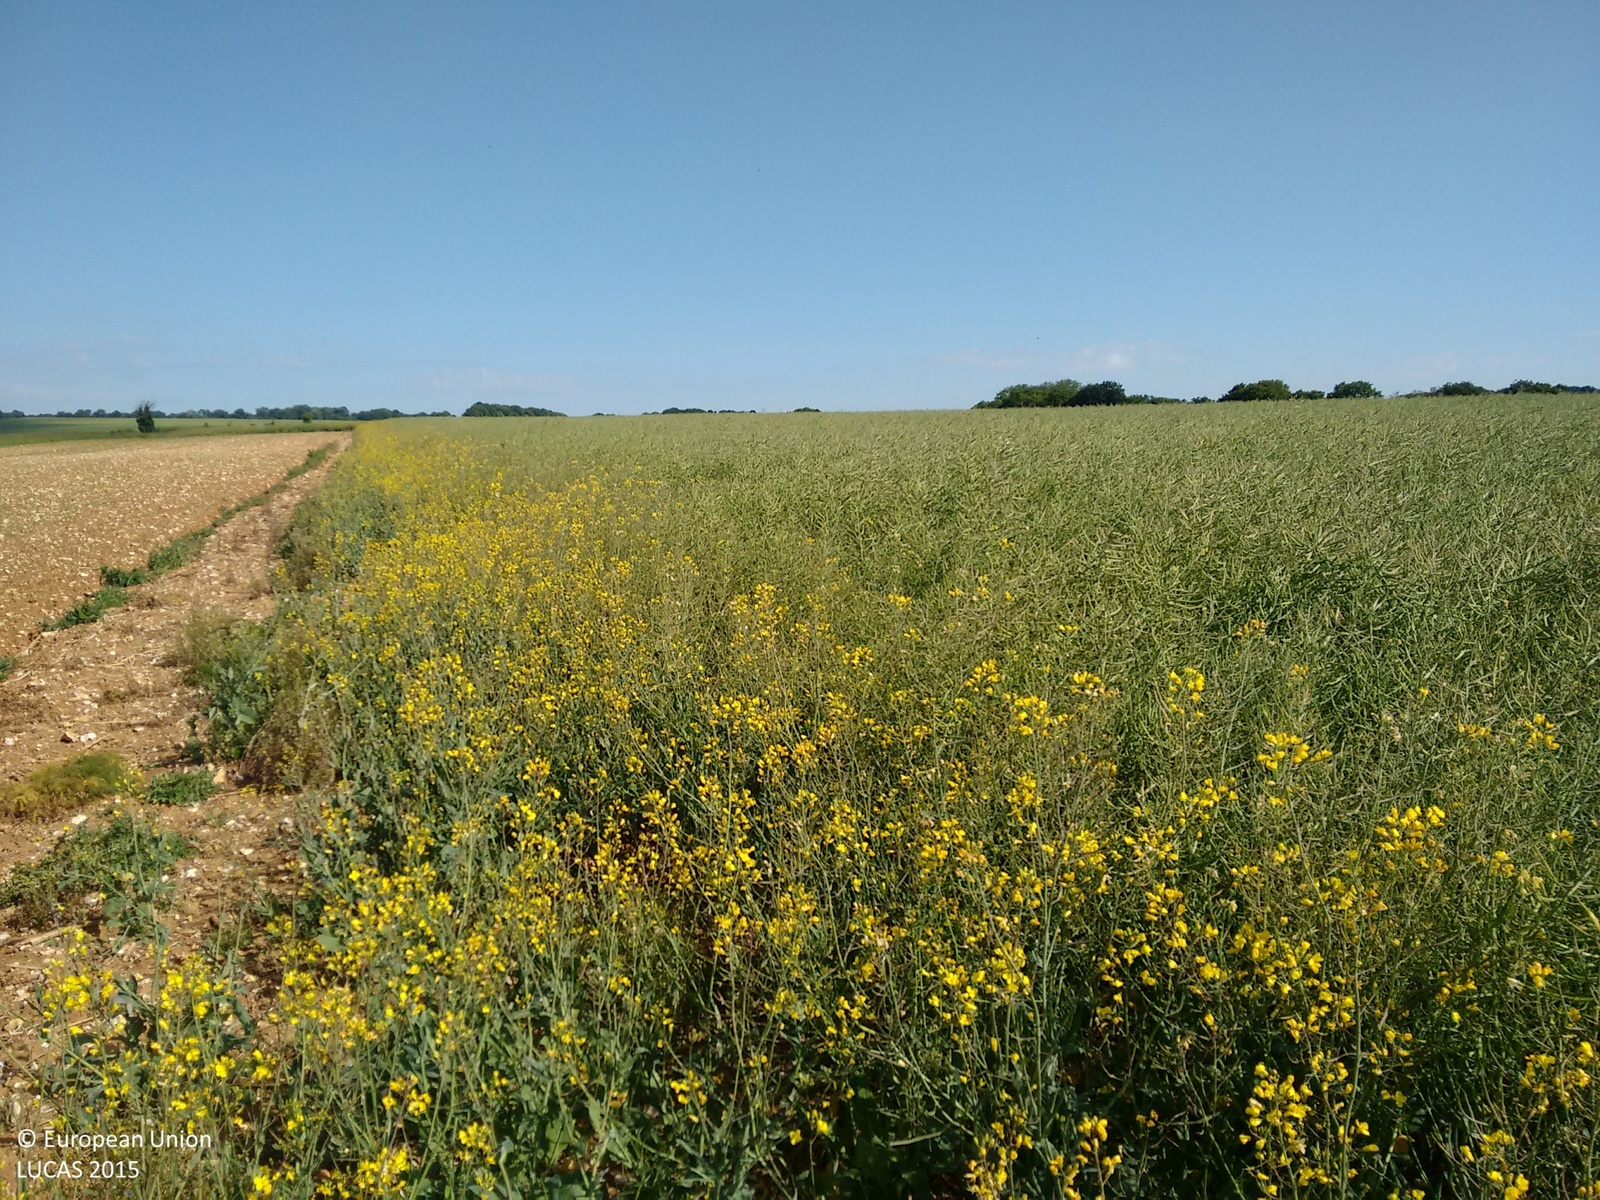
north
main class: Cropland
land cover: Rape and turnip rape
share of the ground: > 75 %
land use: Agriculture (excluding fallow land and kitchen gardens)
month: June
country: GB
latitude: 51.0180
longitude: -1.6715
